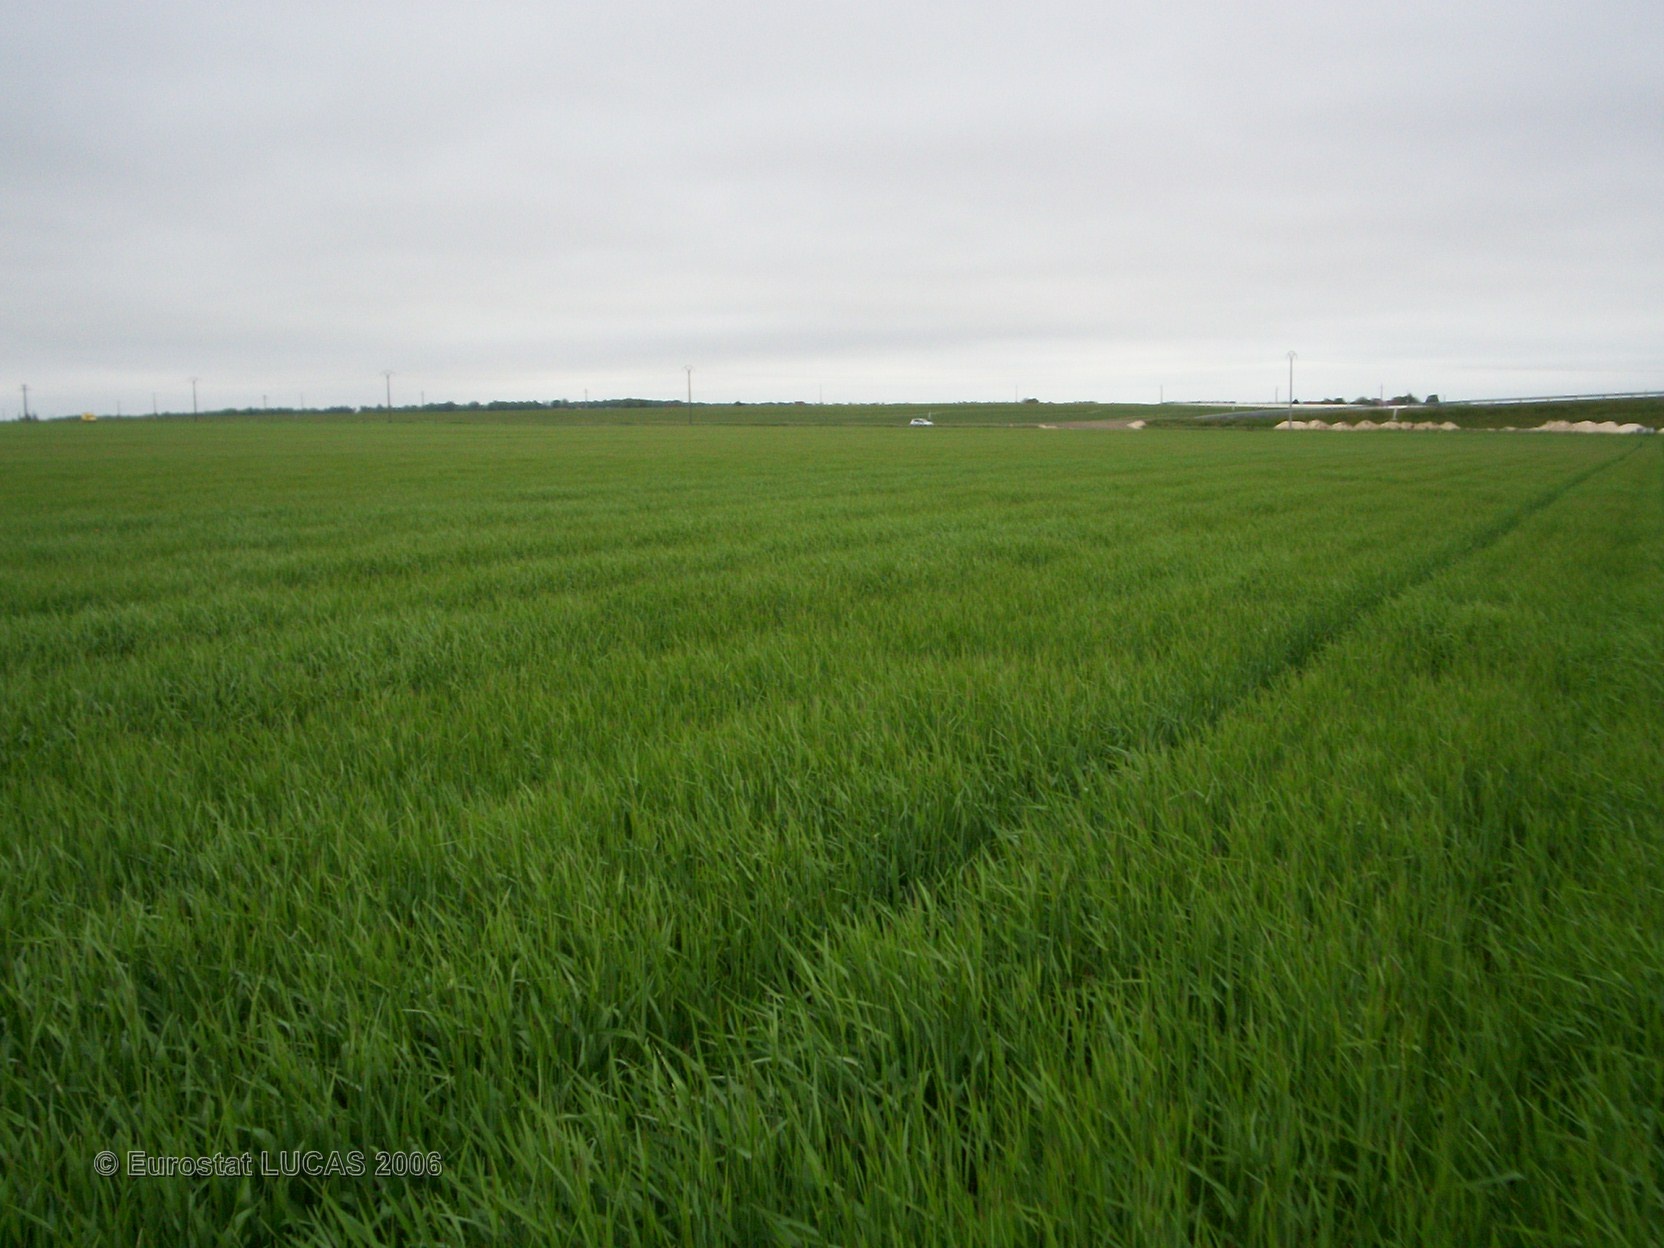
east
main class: Cropland
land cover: Triticale
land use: Agriculture (excluding fallow land and kitchen gardens)
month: May
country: FR
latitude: 47.3029
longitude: 0.8963
